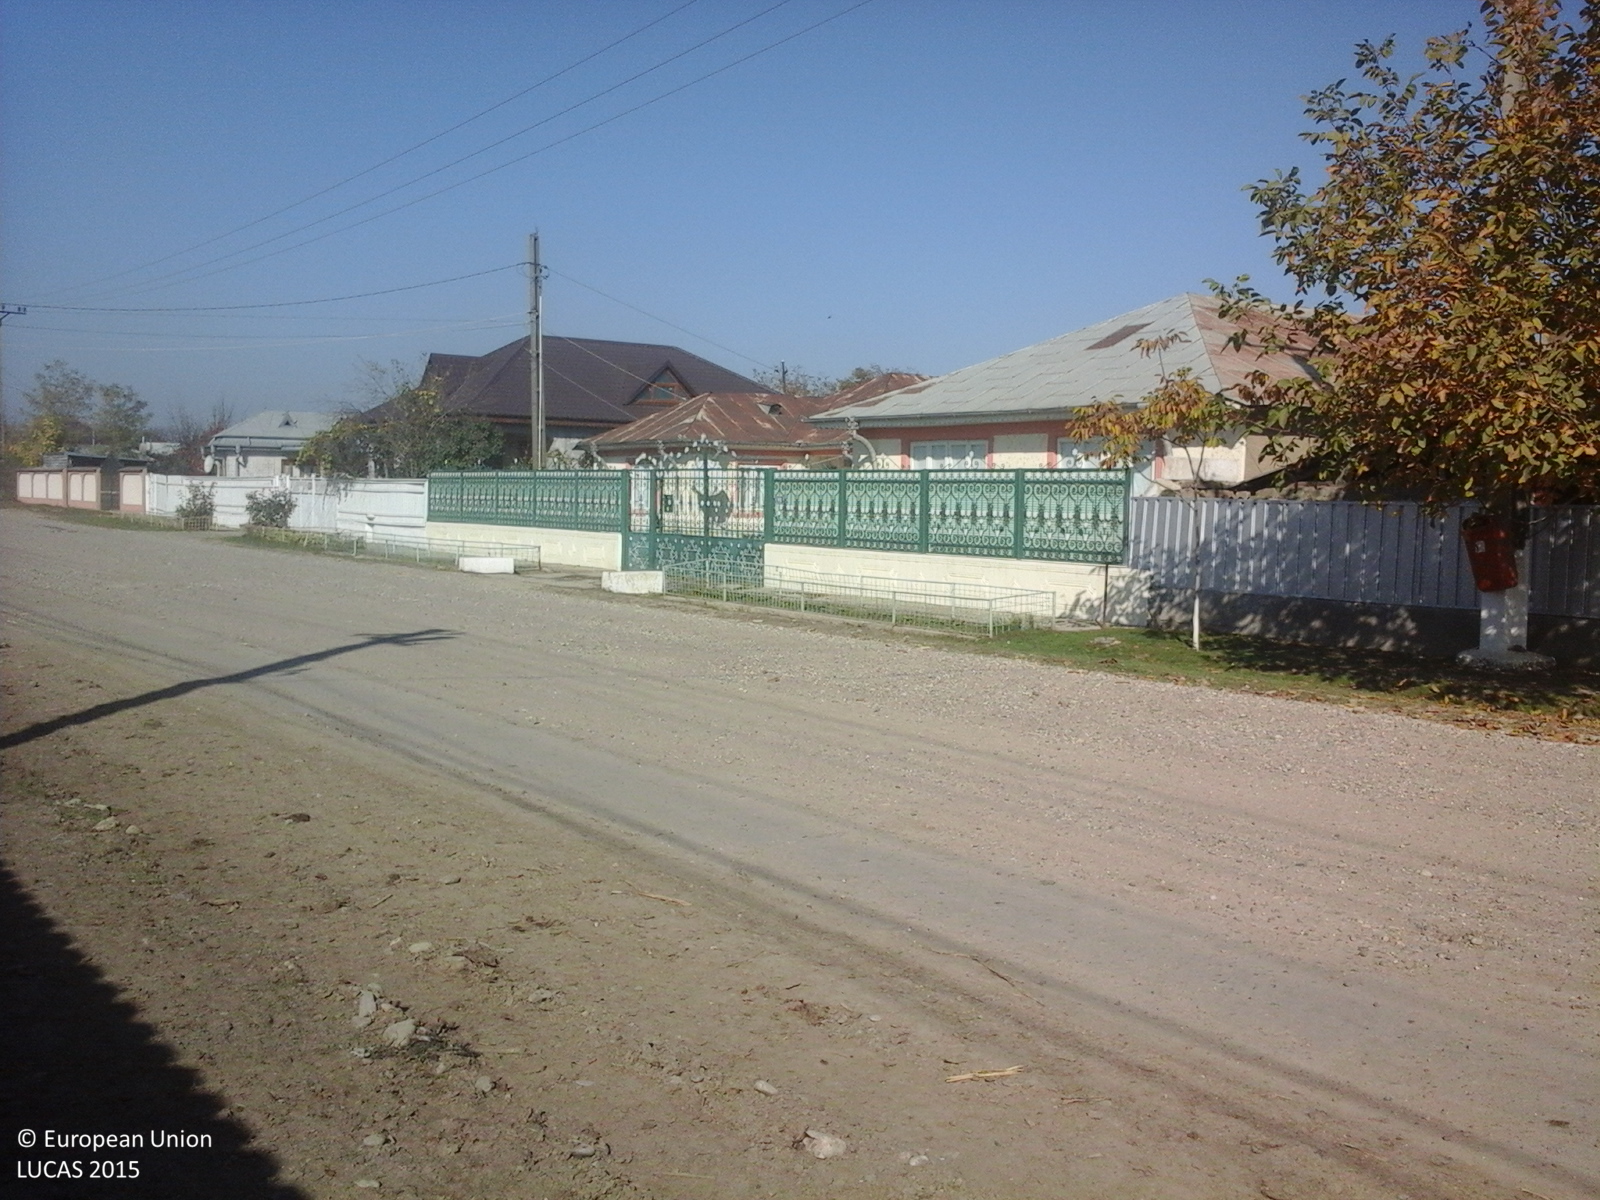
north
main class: Cropland
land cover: Maize
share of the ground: 25 - 50 %
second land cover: Spontaneously vegetated surfaces
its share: 25 - 50 %
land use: Kitchen garden
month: October
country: RO
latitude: 45.6673
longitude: 27.3903
